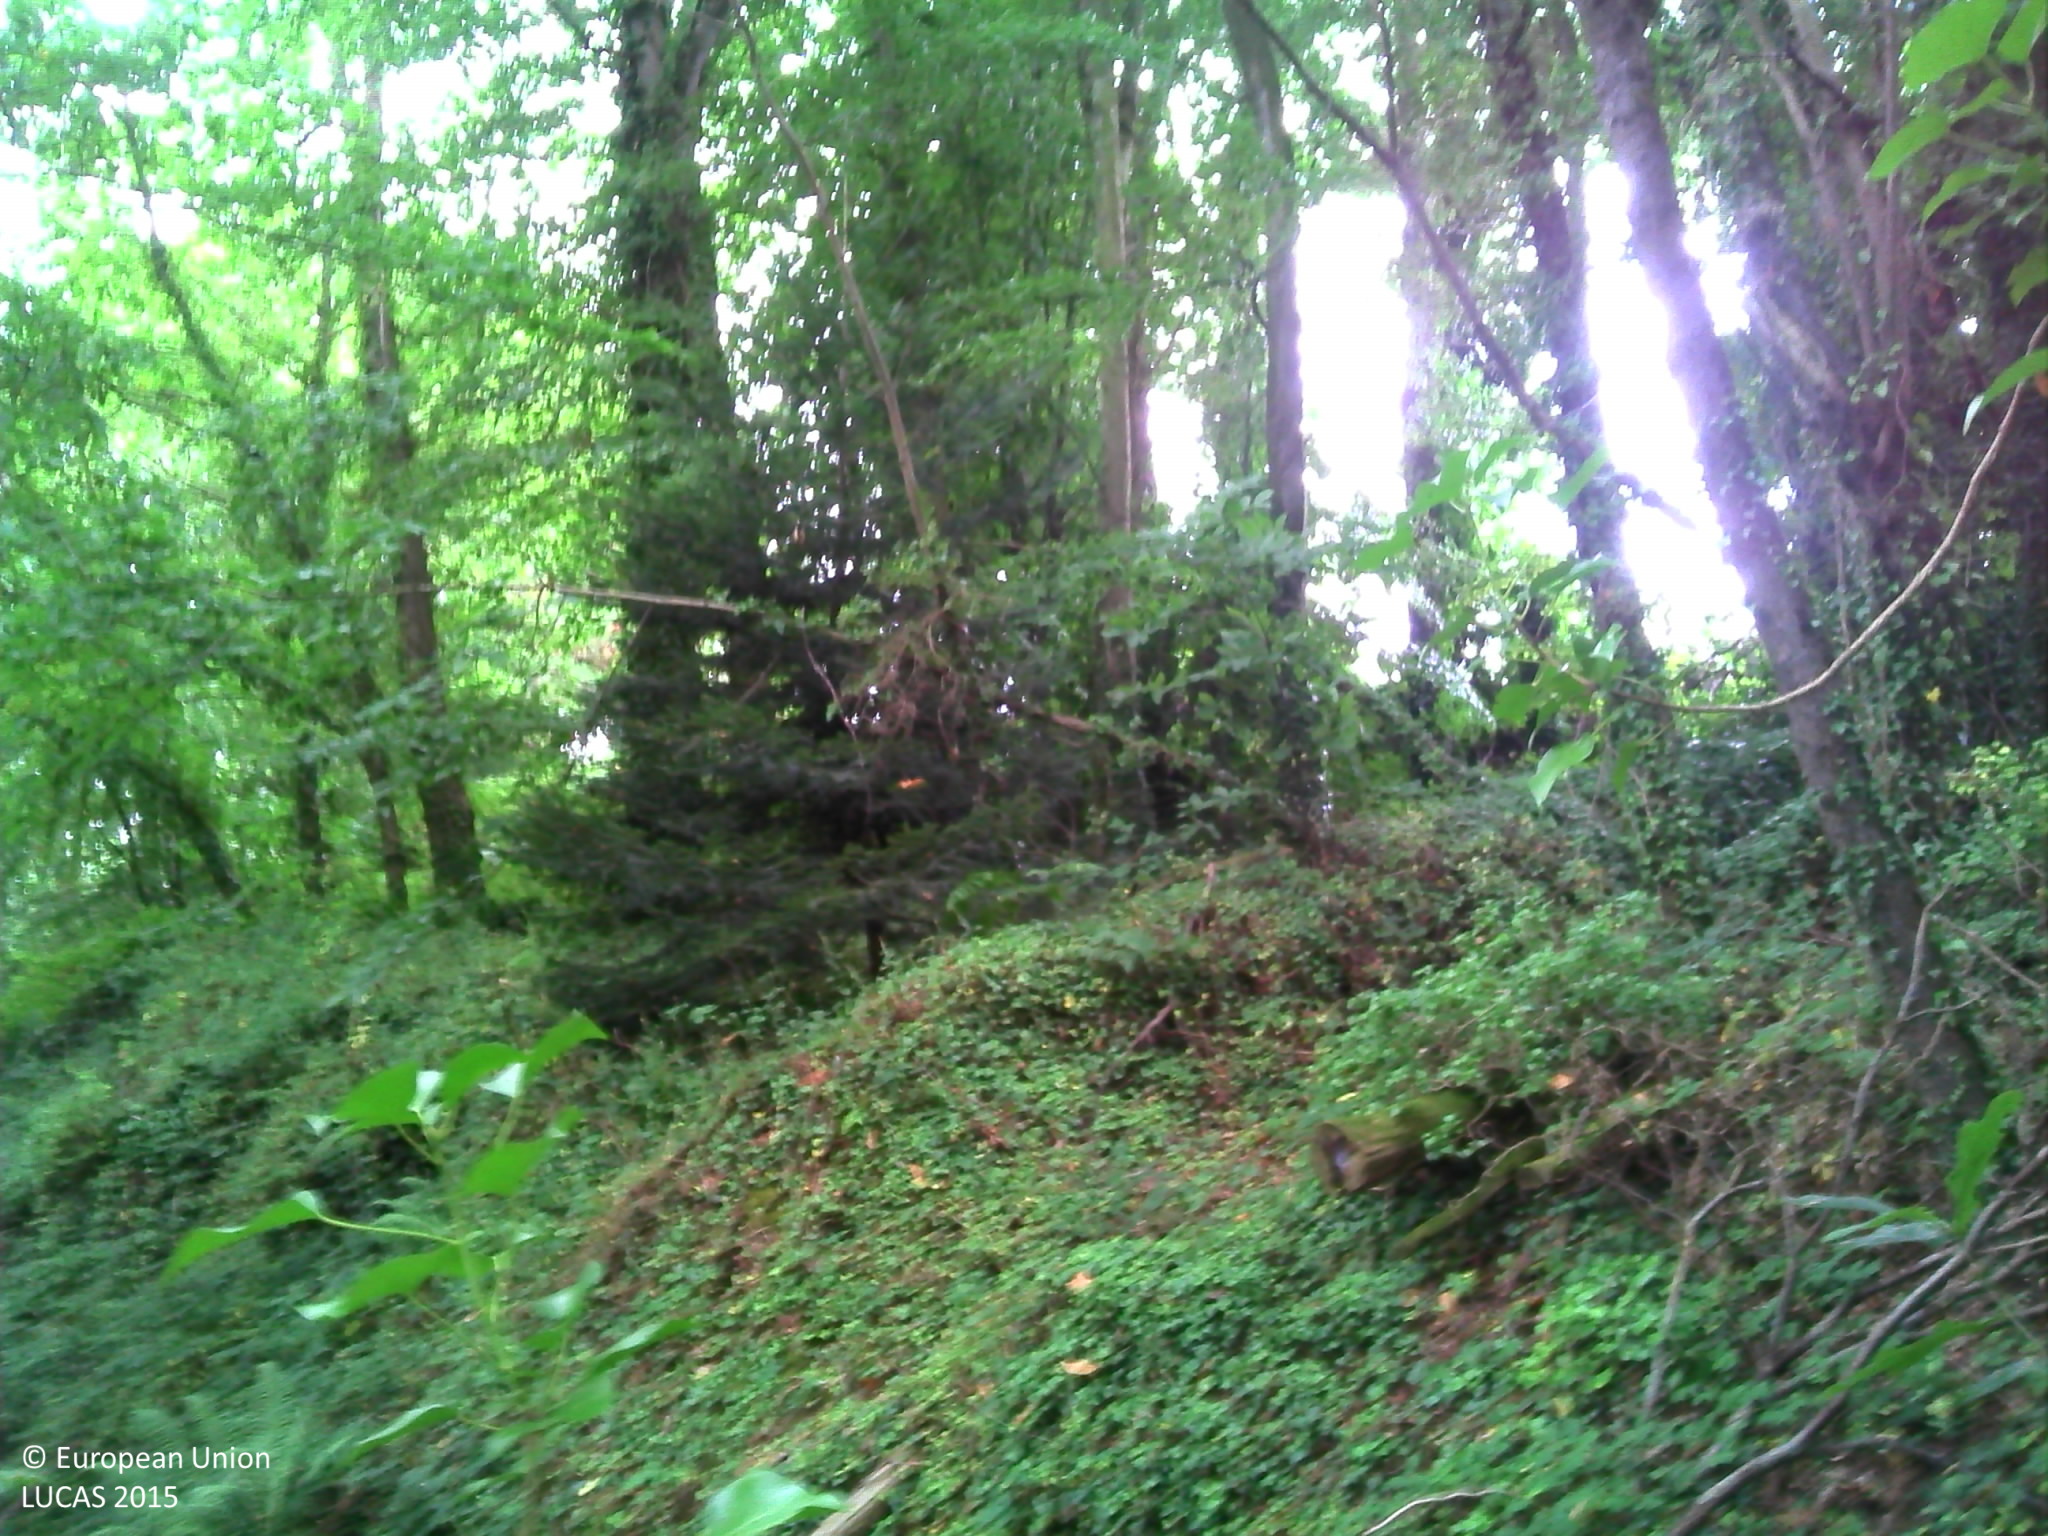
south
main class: Woodland
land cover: Broadleaved woodland
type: mesophytic deciduous forest
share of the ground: > 75 %
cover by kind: broadleaved forest trees 50 %, herbaceous plants 30 %, shrubs 20 %
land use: Forestry
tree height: > 5 m
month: August
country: FR
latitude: 48.8269
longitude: -3.2198
